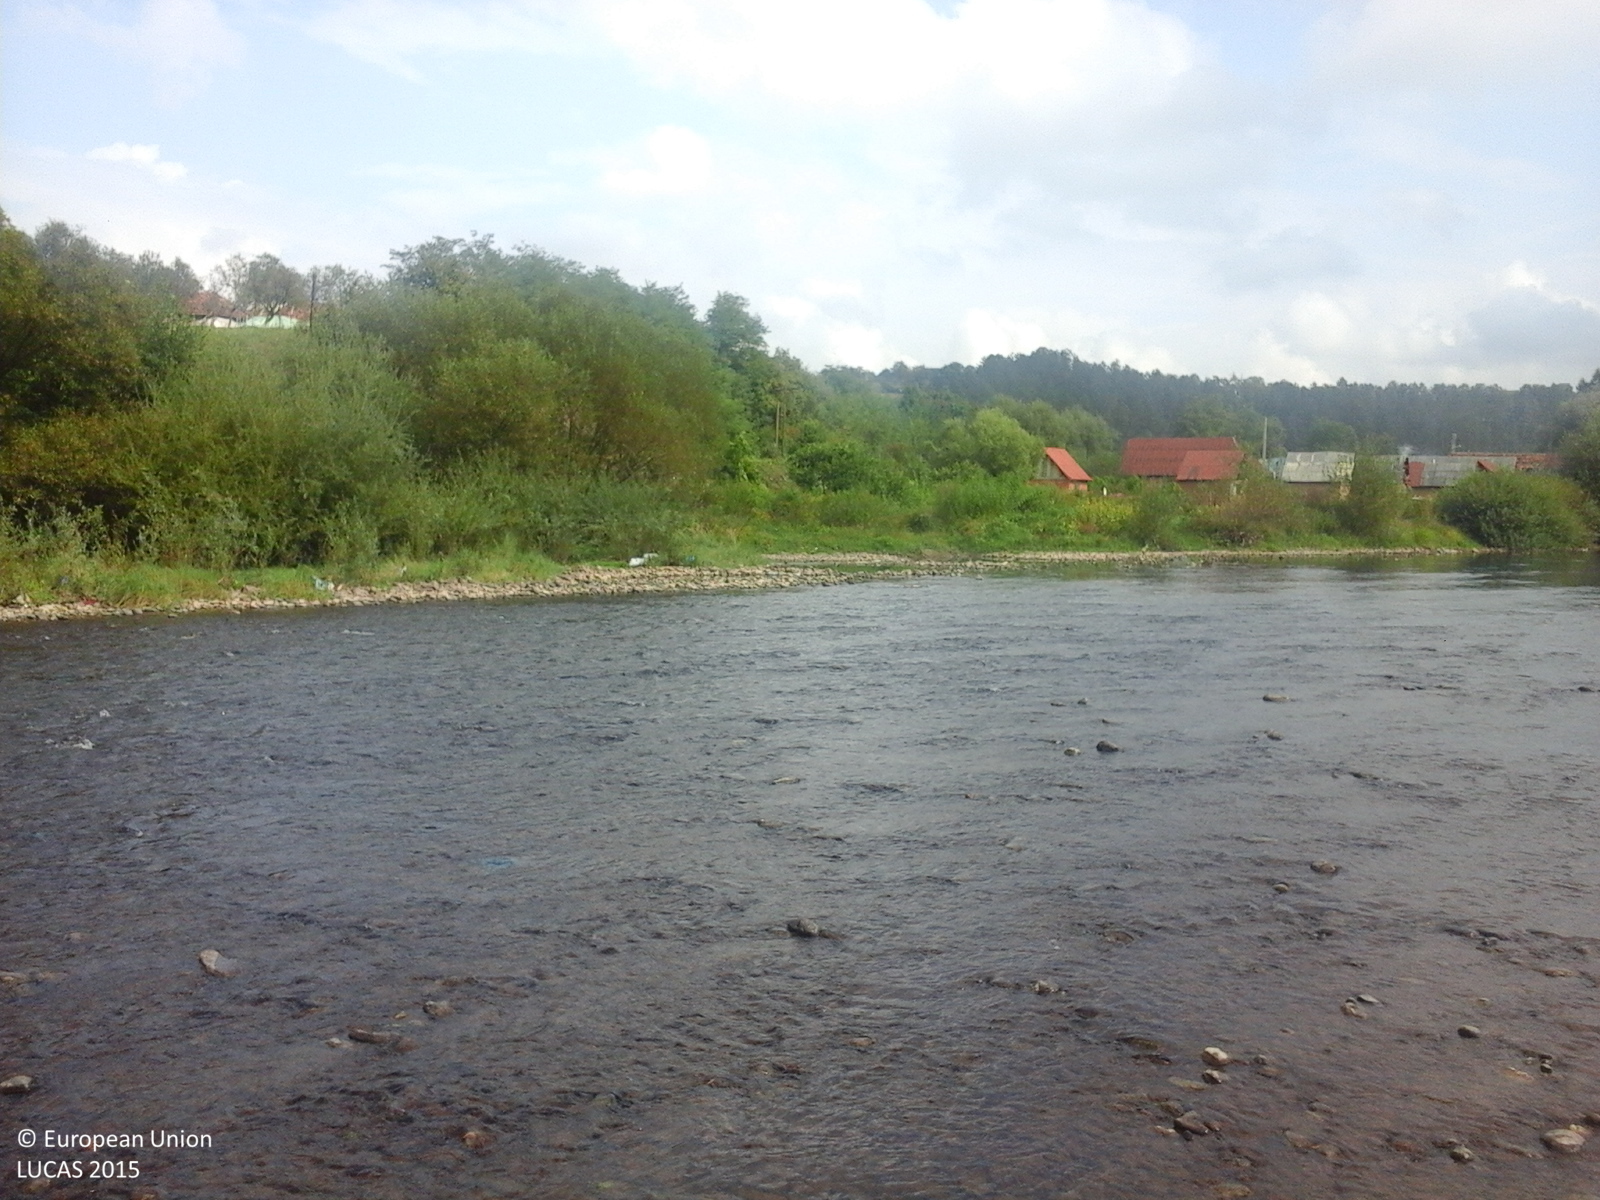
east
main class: Grassland
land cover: Grassland without tree/shrub cover
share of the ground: > 75 %
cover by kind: herbaceous plants 100 %
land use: Agriculture (excluding fallow land and kitchen gardens)
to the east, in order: Grassland without tree/shrub cover; Inland fresh running water; Lines of trees; Spontaneously vegetated surfaces; Tracks; Spontaneously vegetated surfaces; Electric lines; Shruby margins; Railways; Lines of trees; Shrubland with sparse tree cover; Other fruit trees and berries; Artificial constructions in urban areas; Other fresh vegetables
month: September
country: RO
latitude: 46.9357
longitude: 22.5731
